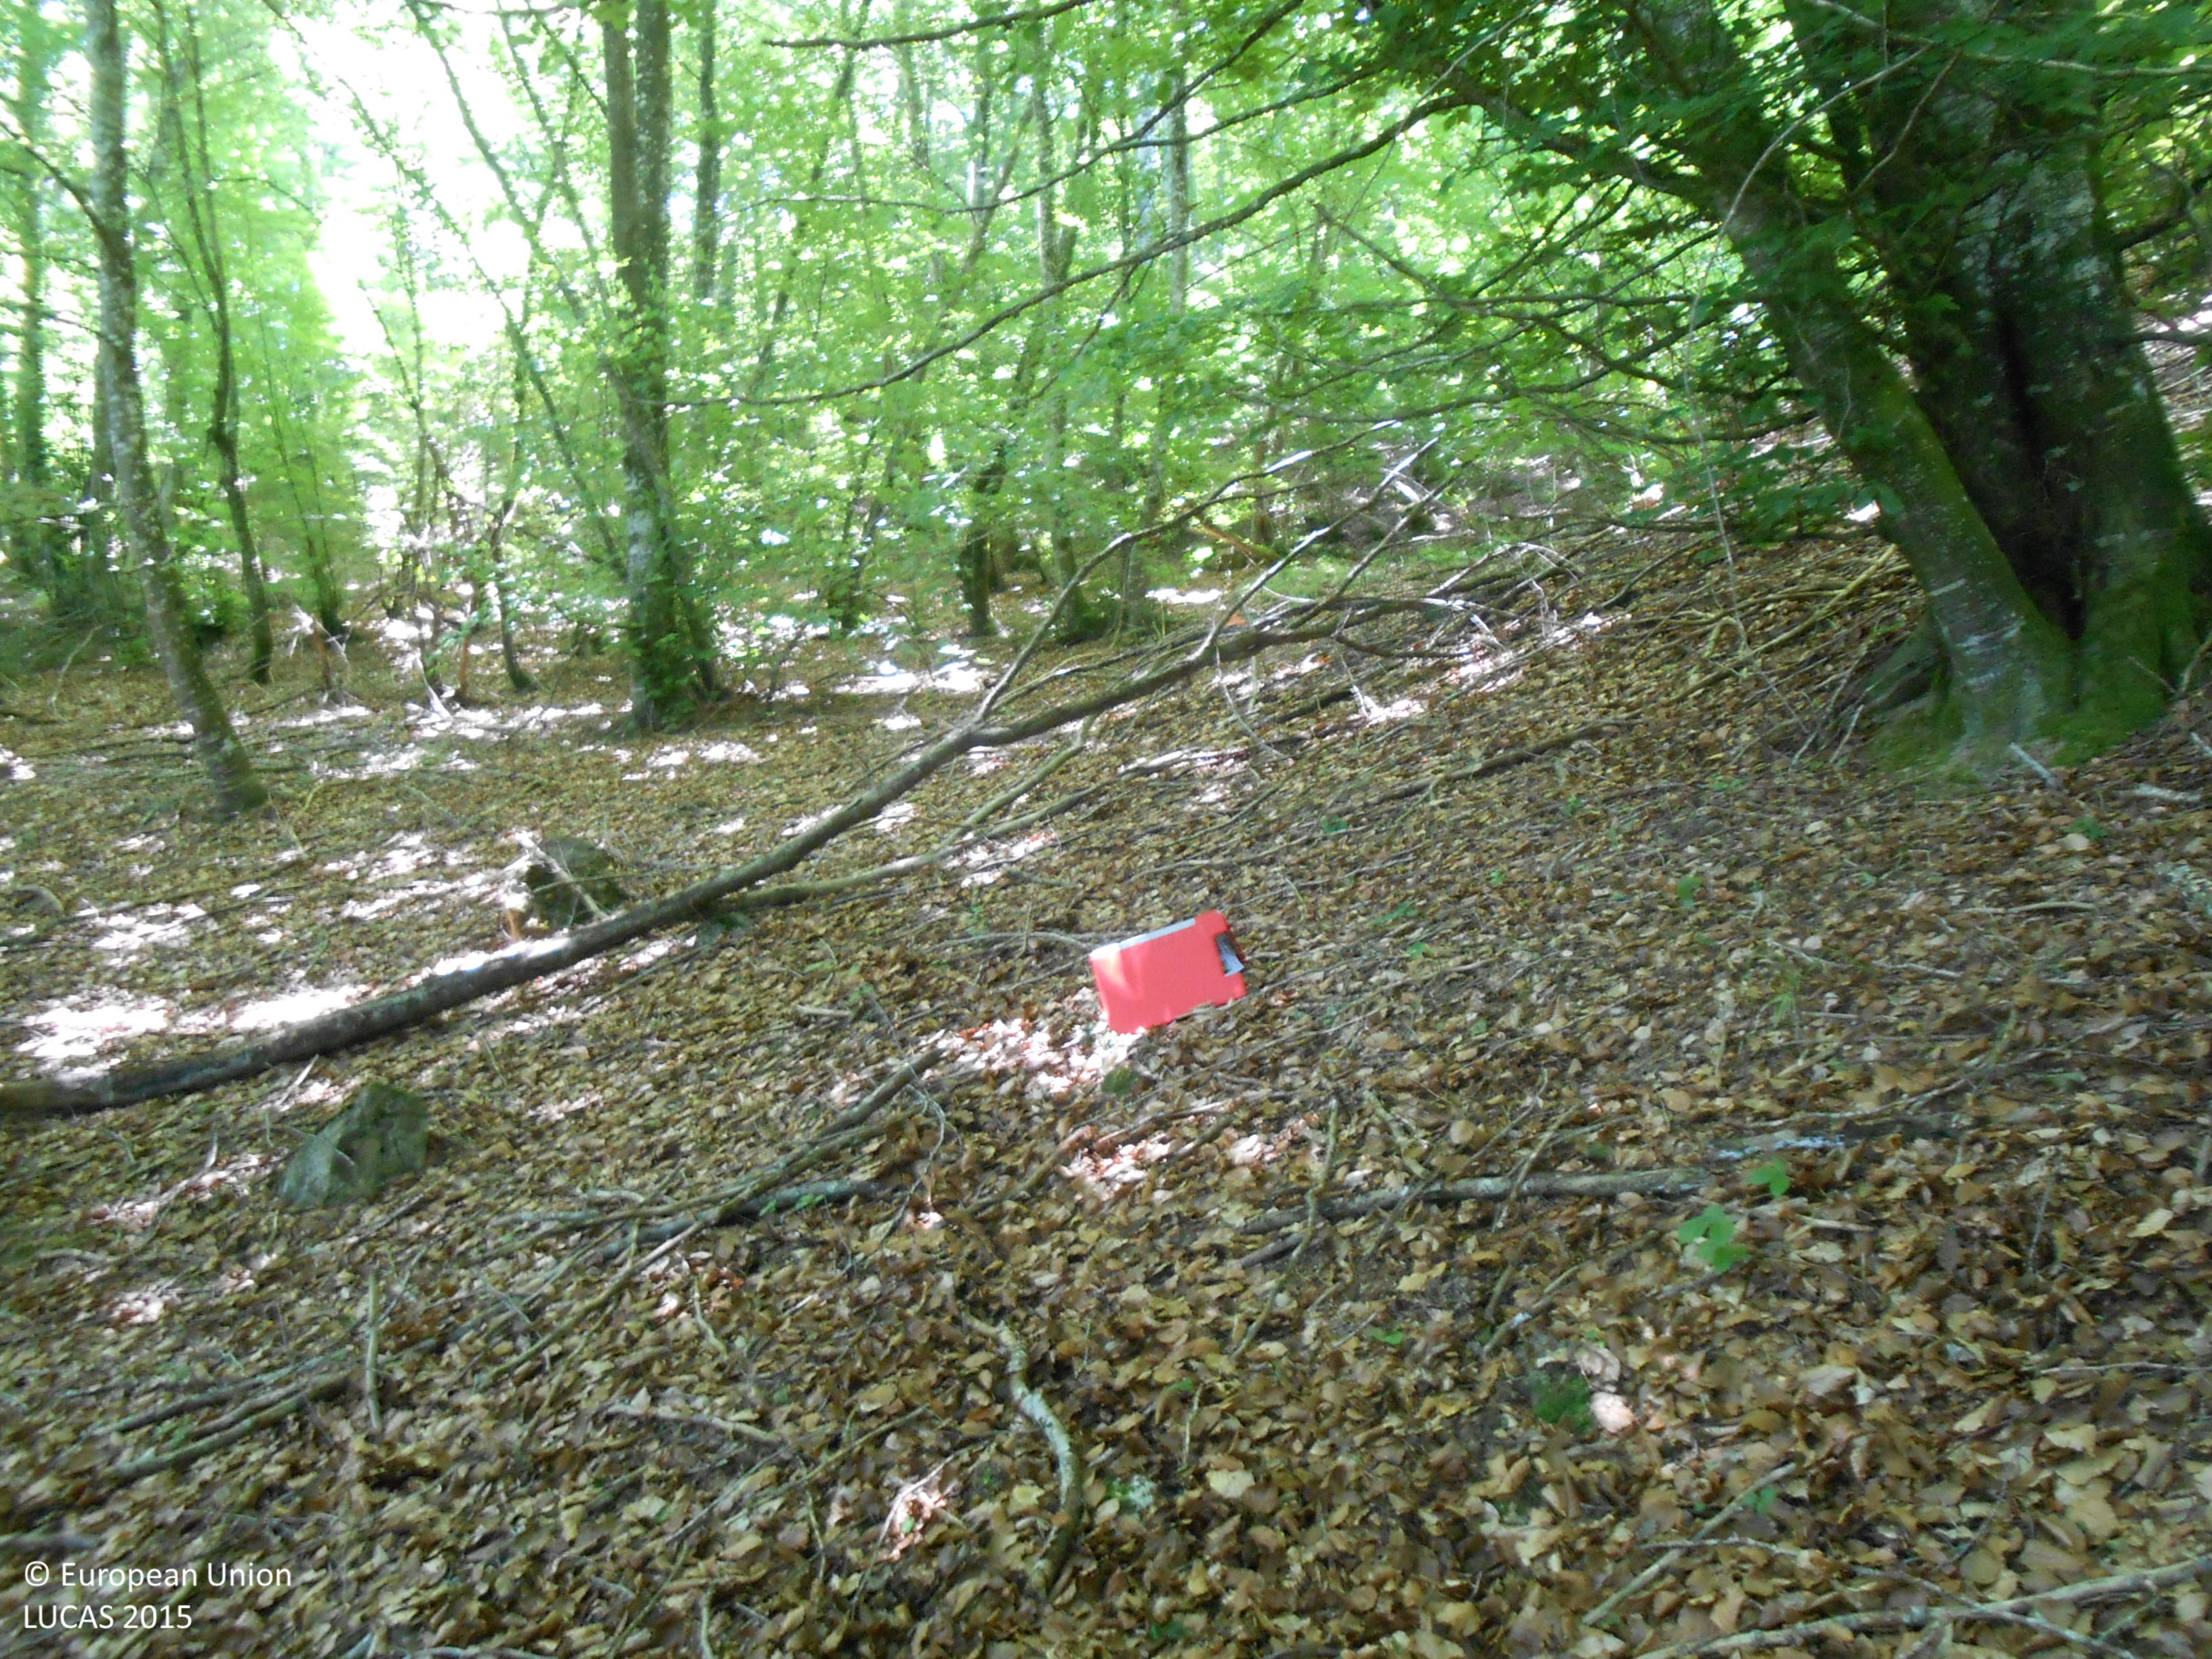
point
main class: Woodland
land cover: Broadleaved woodland
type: beech forest
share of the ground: > 75 %
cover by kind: broadleaved forest trees 100 %
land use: Forestry
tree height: > 5 m
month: June
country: ES
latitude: 42.9578
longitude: -1.6986
